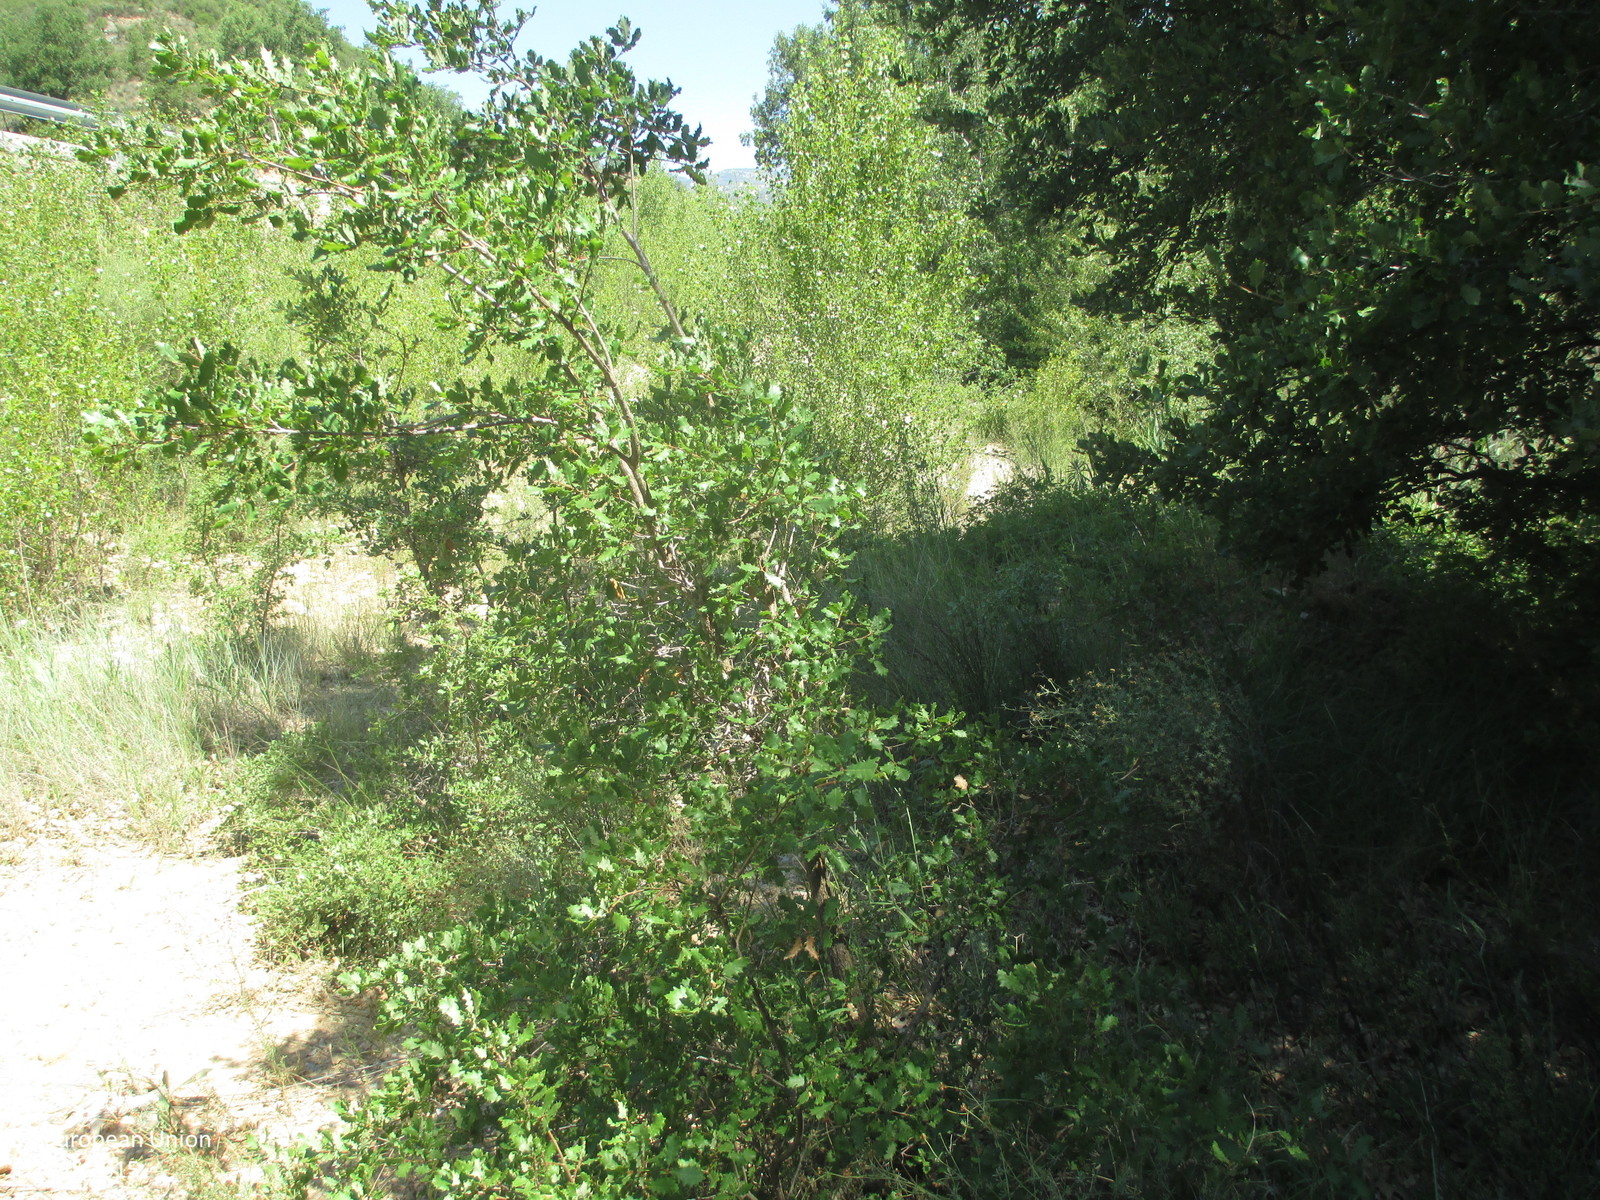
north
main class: Woodland
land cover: Broadleaved woodland
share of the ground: > 75 %
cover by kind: broadleaved forest trees 95 %, shrubs 5 %
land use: Semi-natural and natural areas not in use
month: June
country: ES
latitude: 42.1420
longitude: 0.0222
